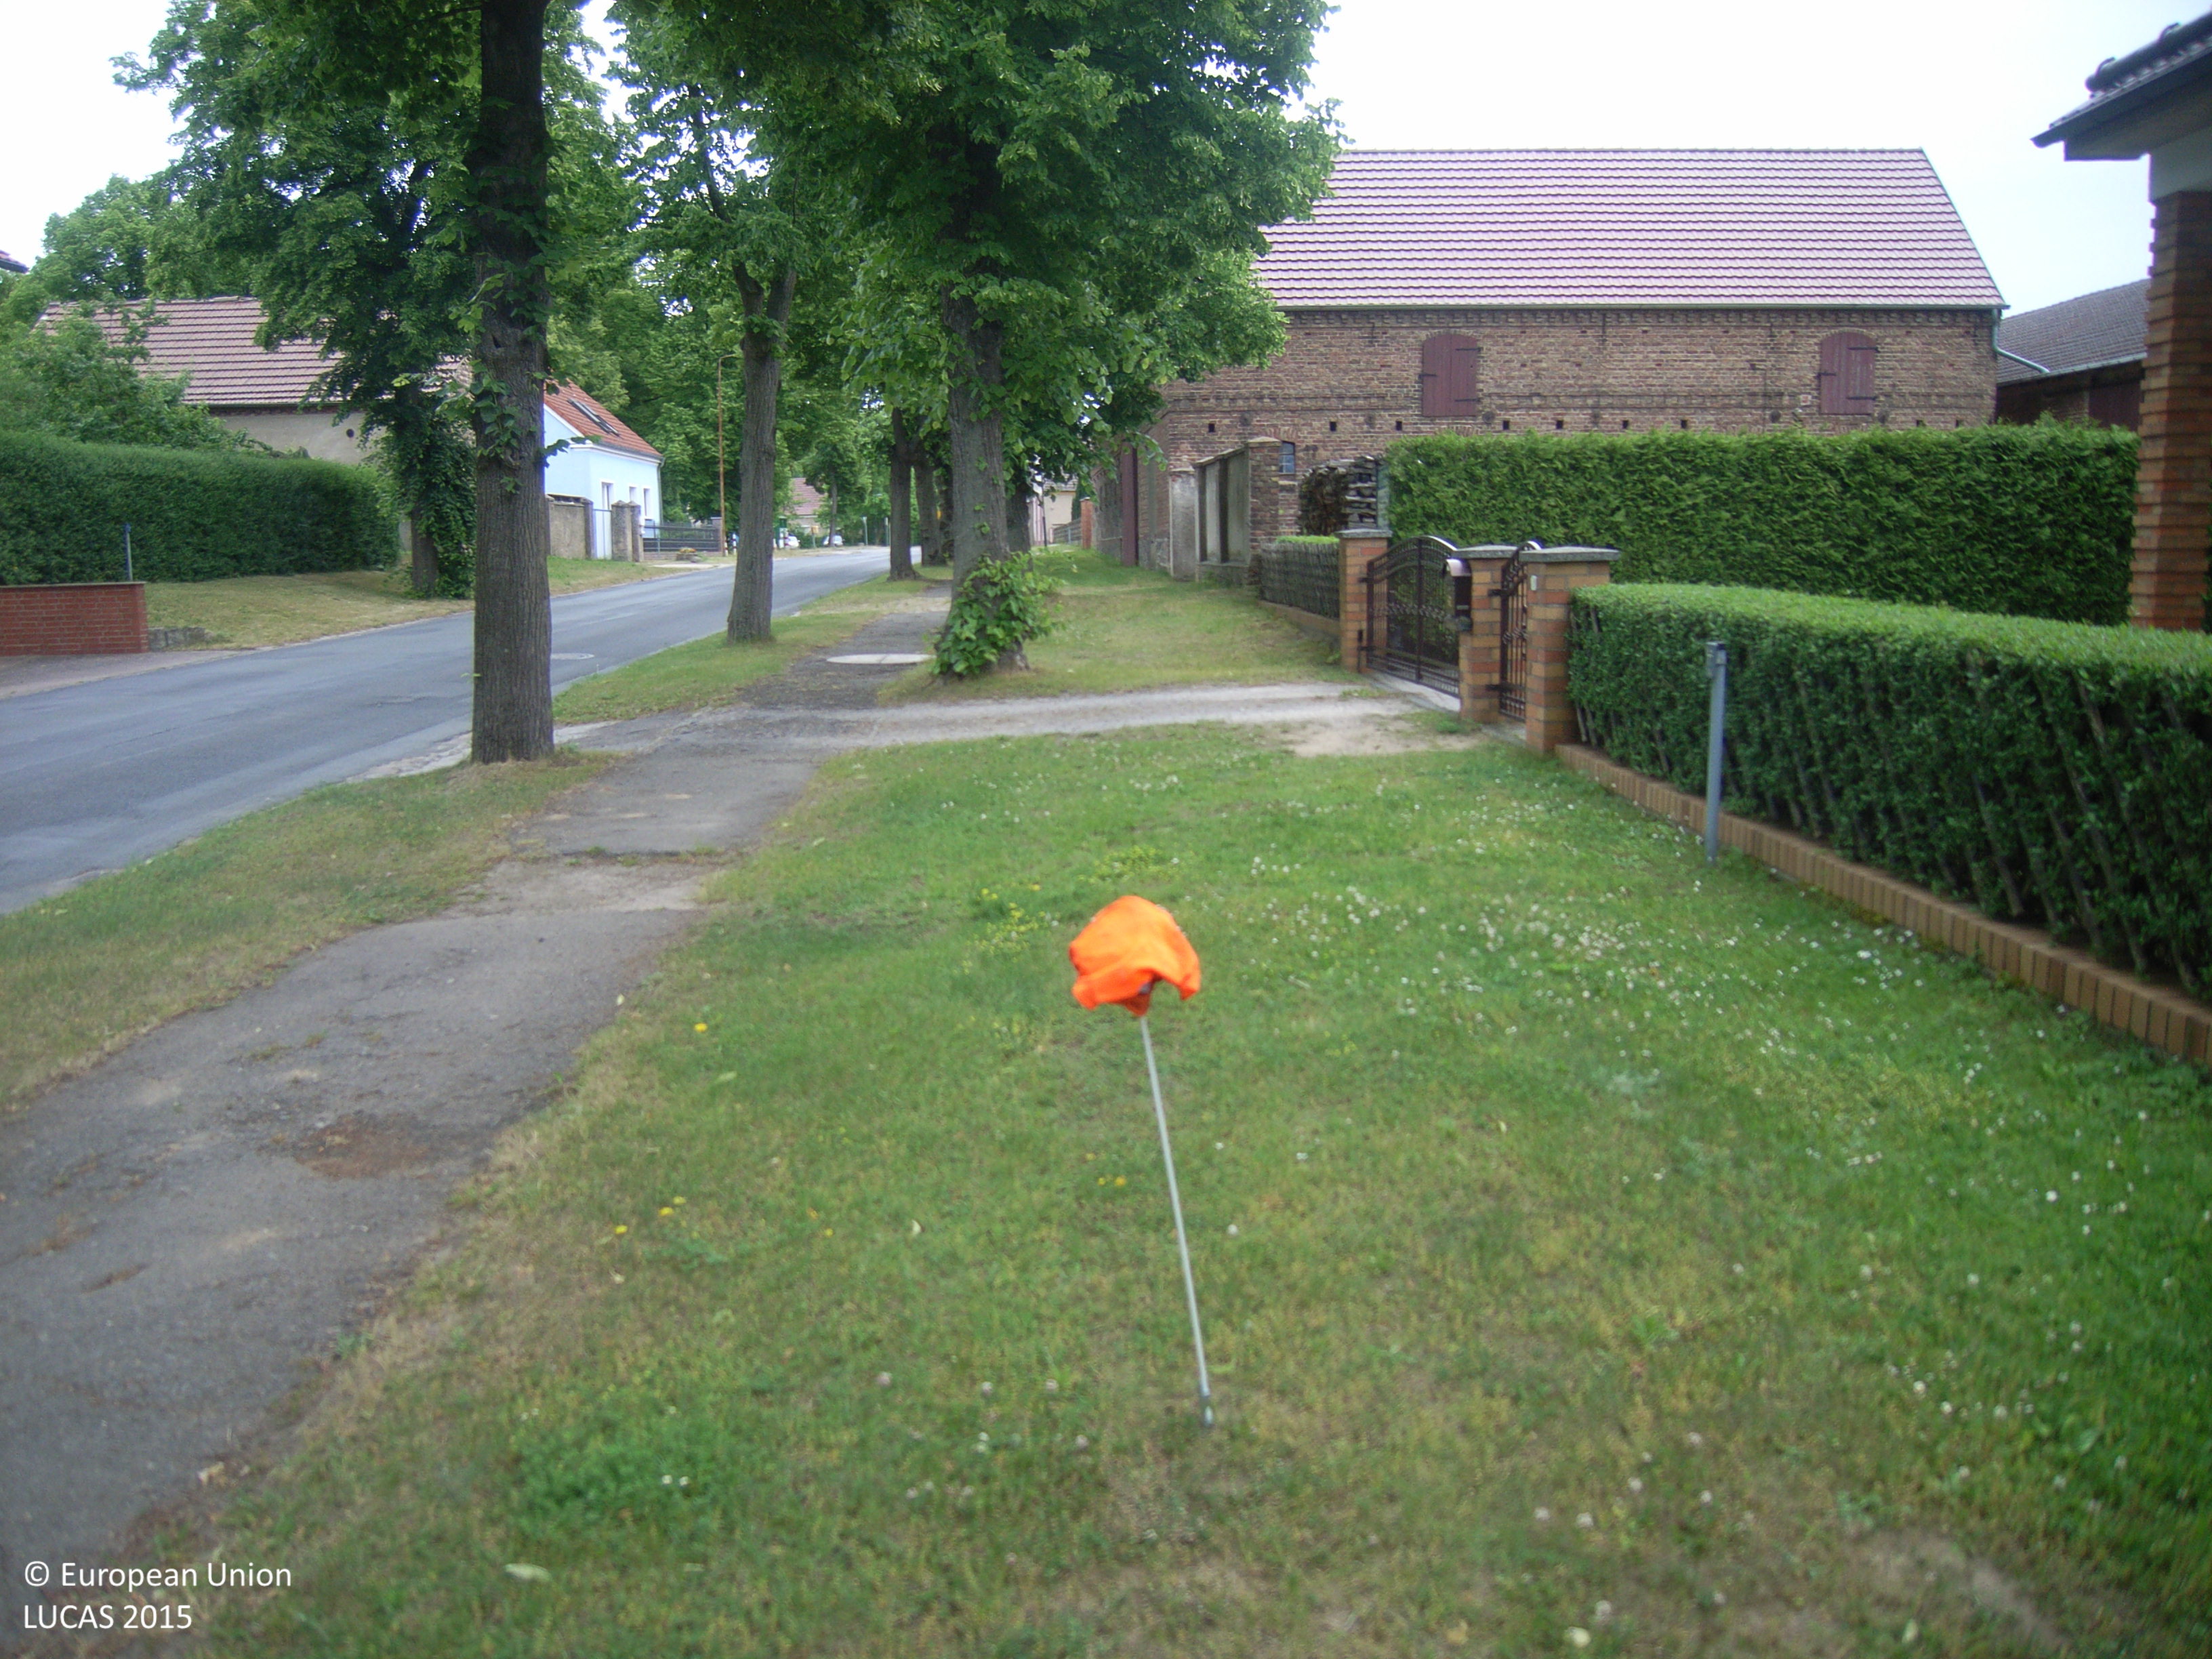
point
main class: Grassland
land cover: Grassland with sparse tree/shrub cover
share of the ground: > 75 %
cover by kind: herbaceous plants 95 %, broadleaved forest trees 5 %
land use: Road transport
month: June
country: DE
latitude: 52.1983
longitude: 14.1122
